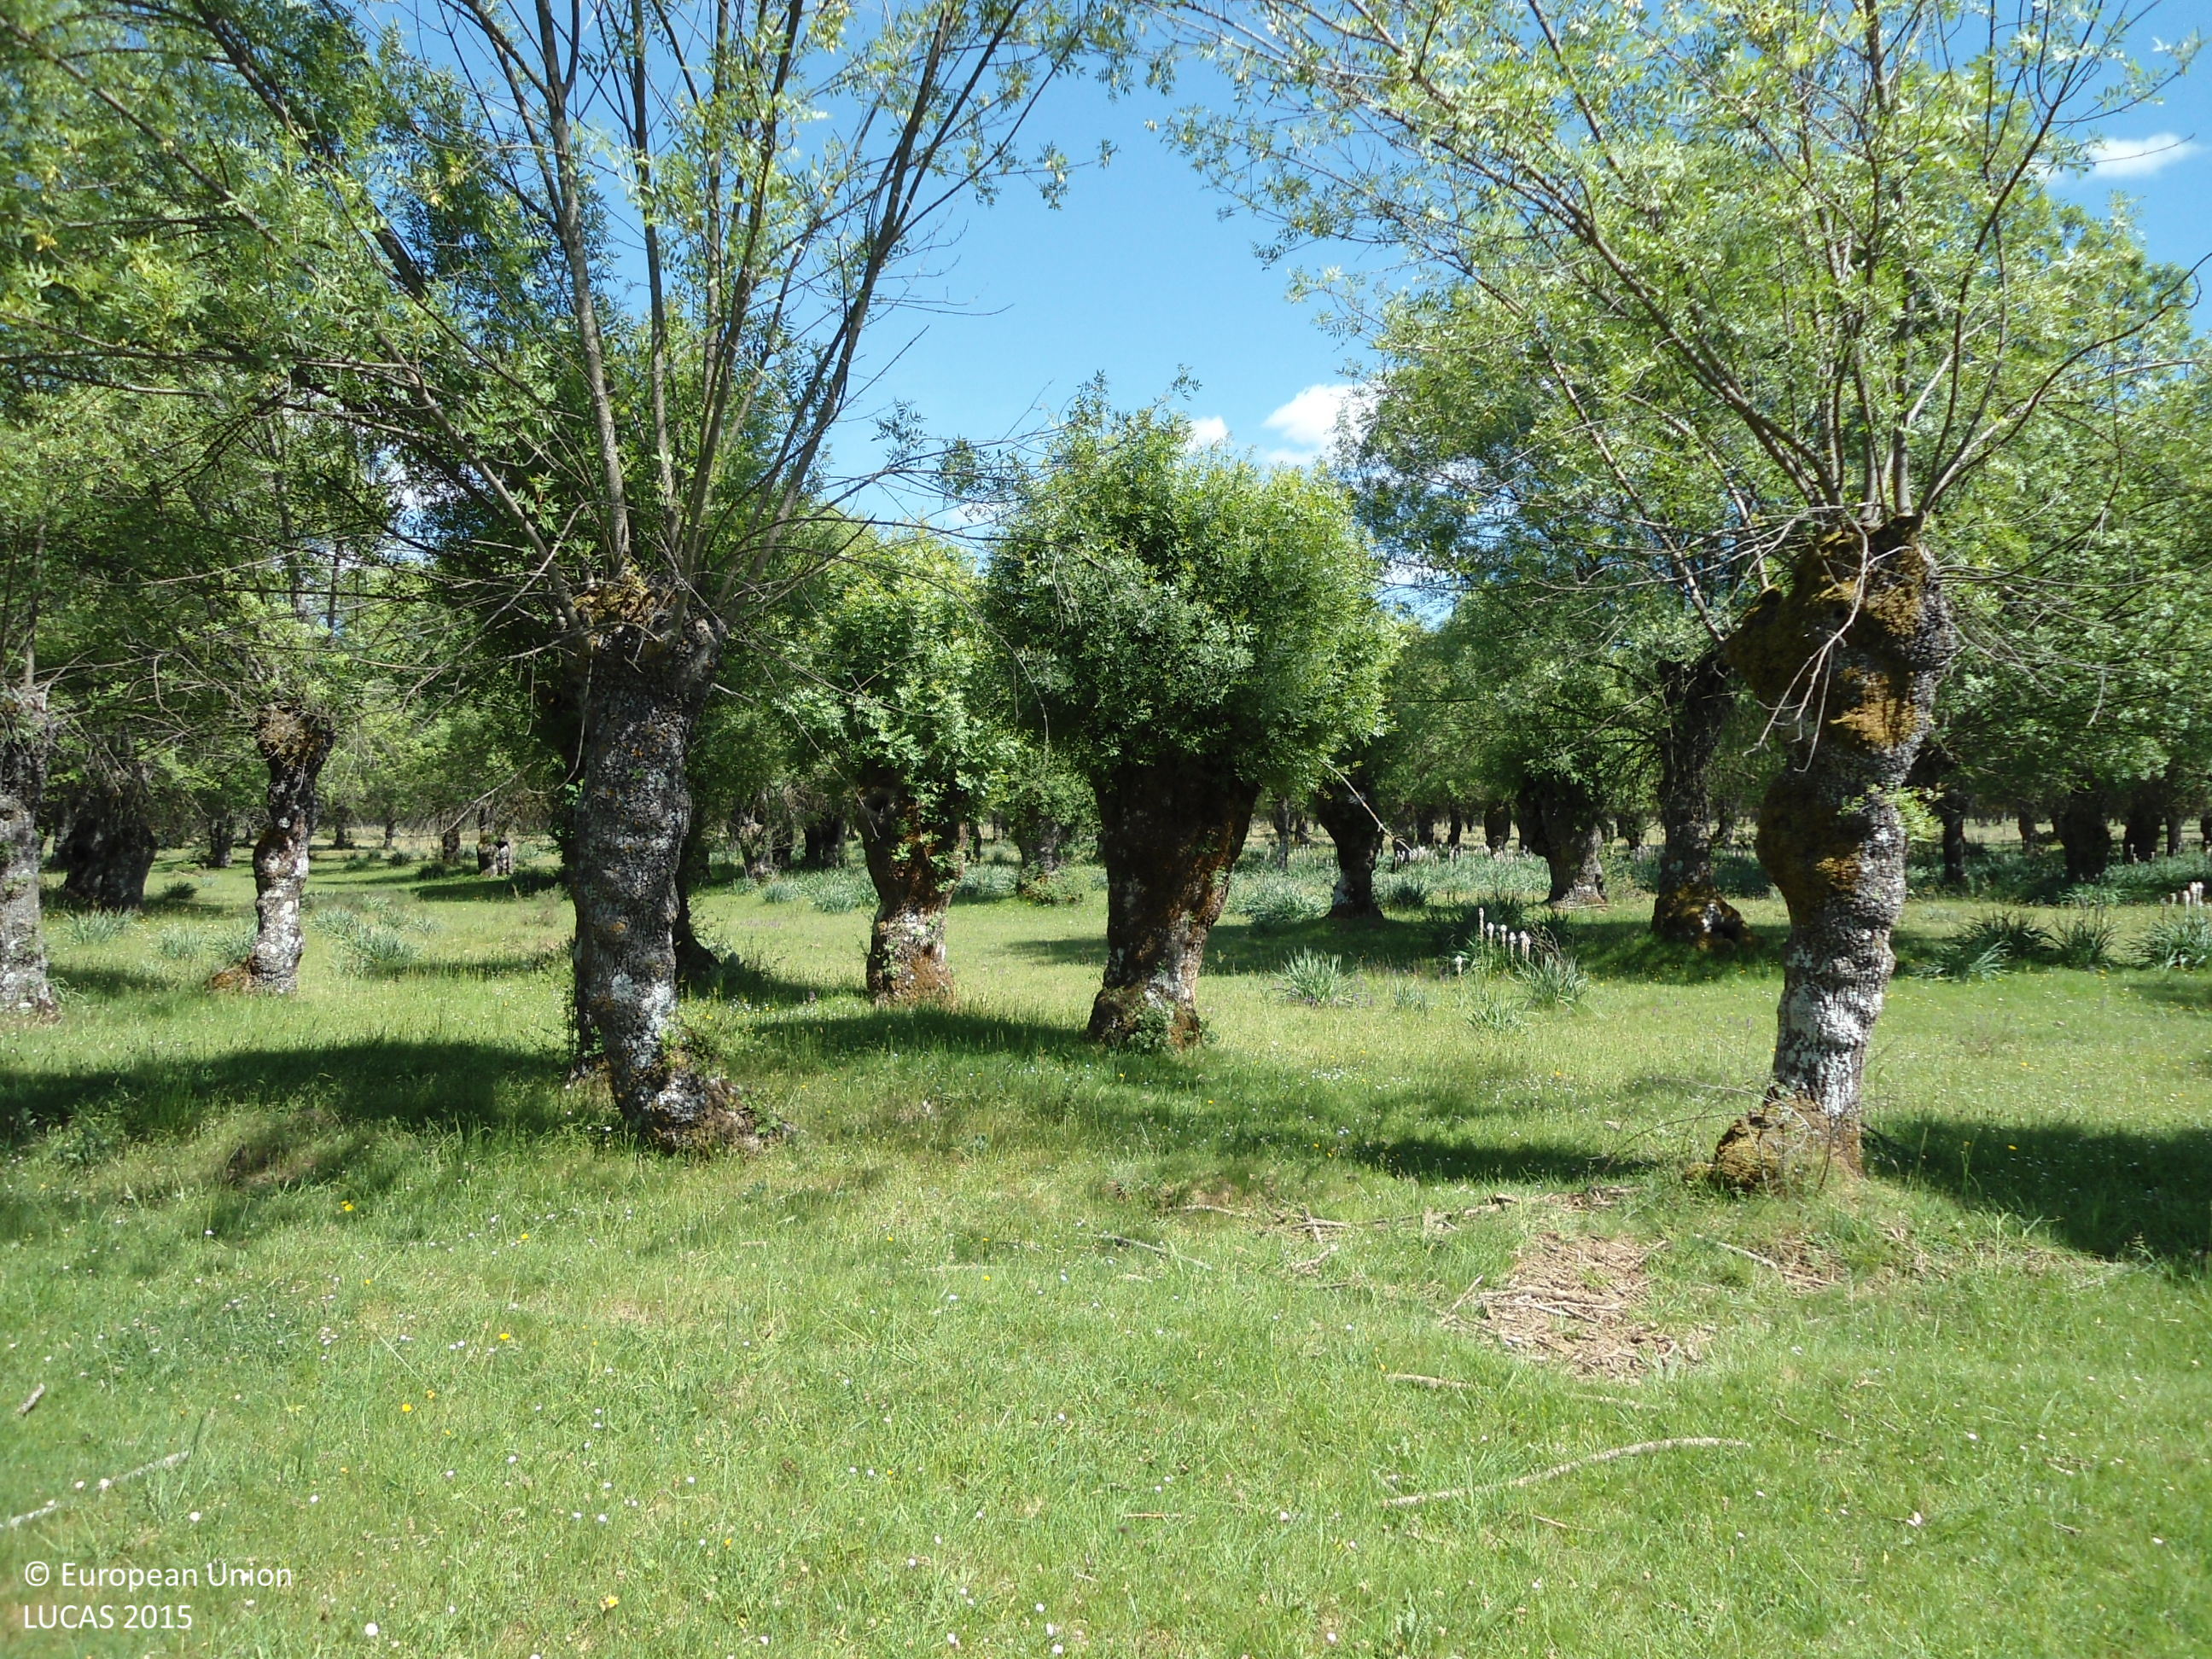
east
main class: Woodland
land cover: Broadleaved woodland
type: floodplain forest
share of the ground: > 75 %
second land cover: Grassland without tree/shrub cover
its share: > 75 %
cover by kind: broadleaved forest trees 75 %, herbaceous plants 25 %
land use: Forestry
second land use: Agriculture (excluding fallow land and kitchen gardens)
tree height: > 5 m
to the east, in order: Broadleaved woodland; Grassland without tree/shrub cover; Tracks; Broadleaved woodland; Fences; Grassland with sparse tree/shrub cover
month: May
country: ES
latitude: 41.9233
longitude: -6.0025
